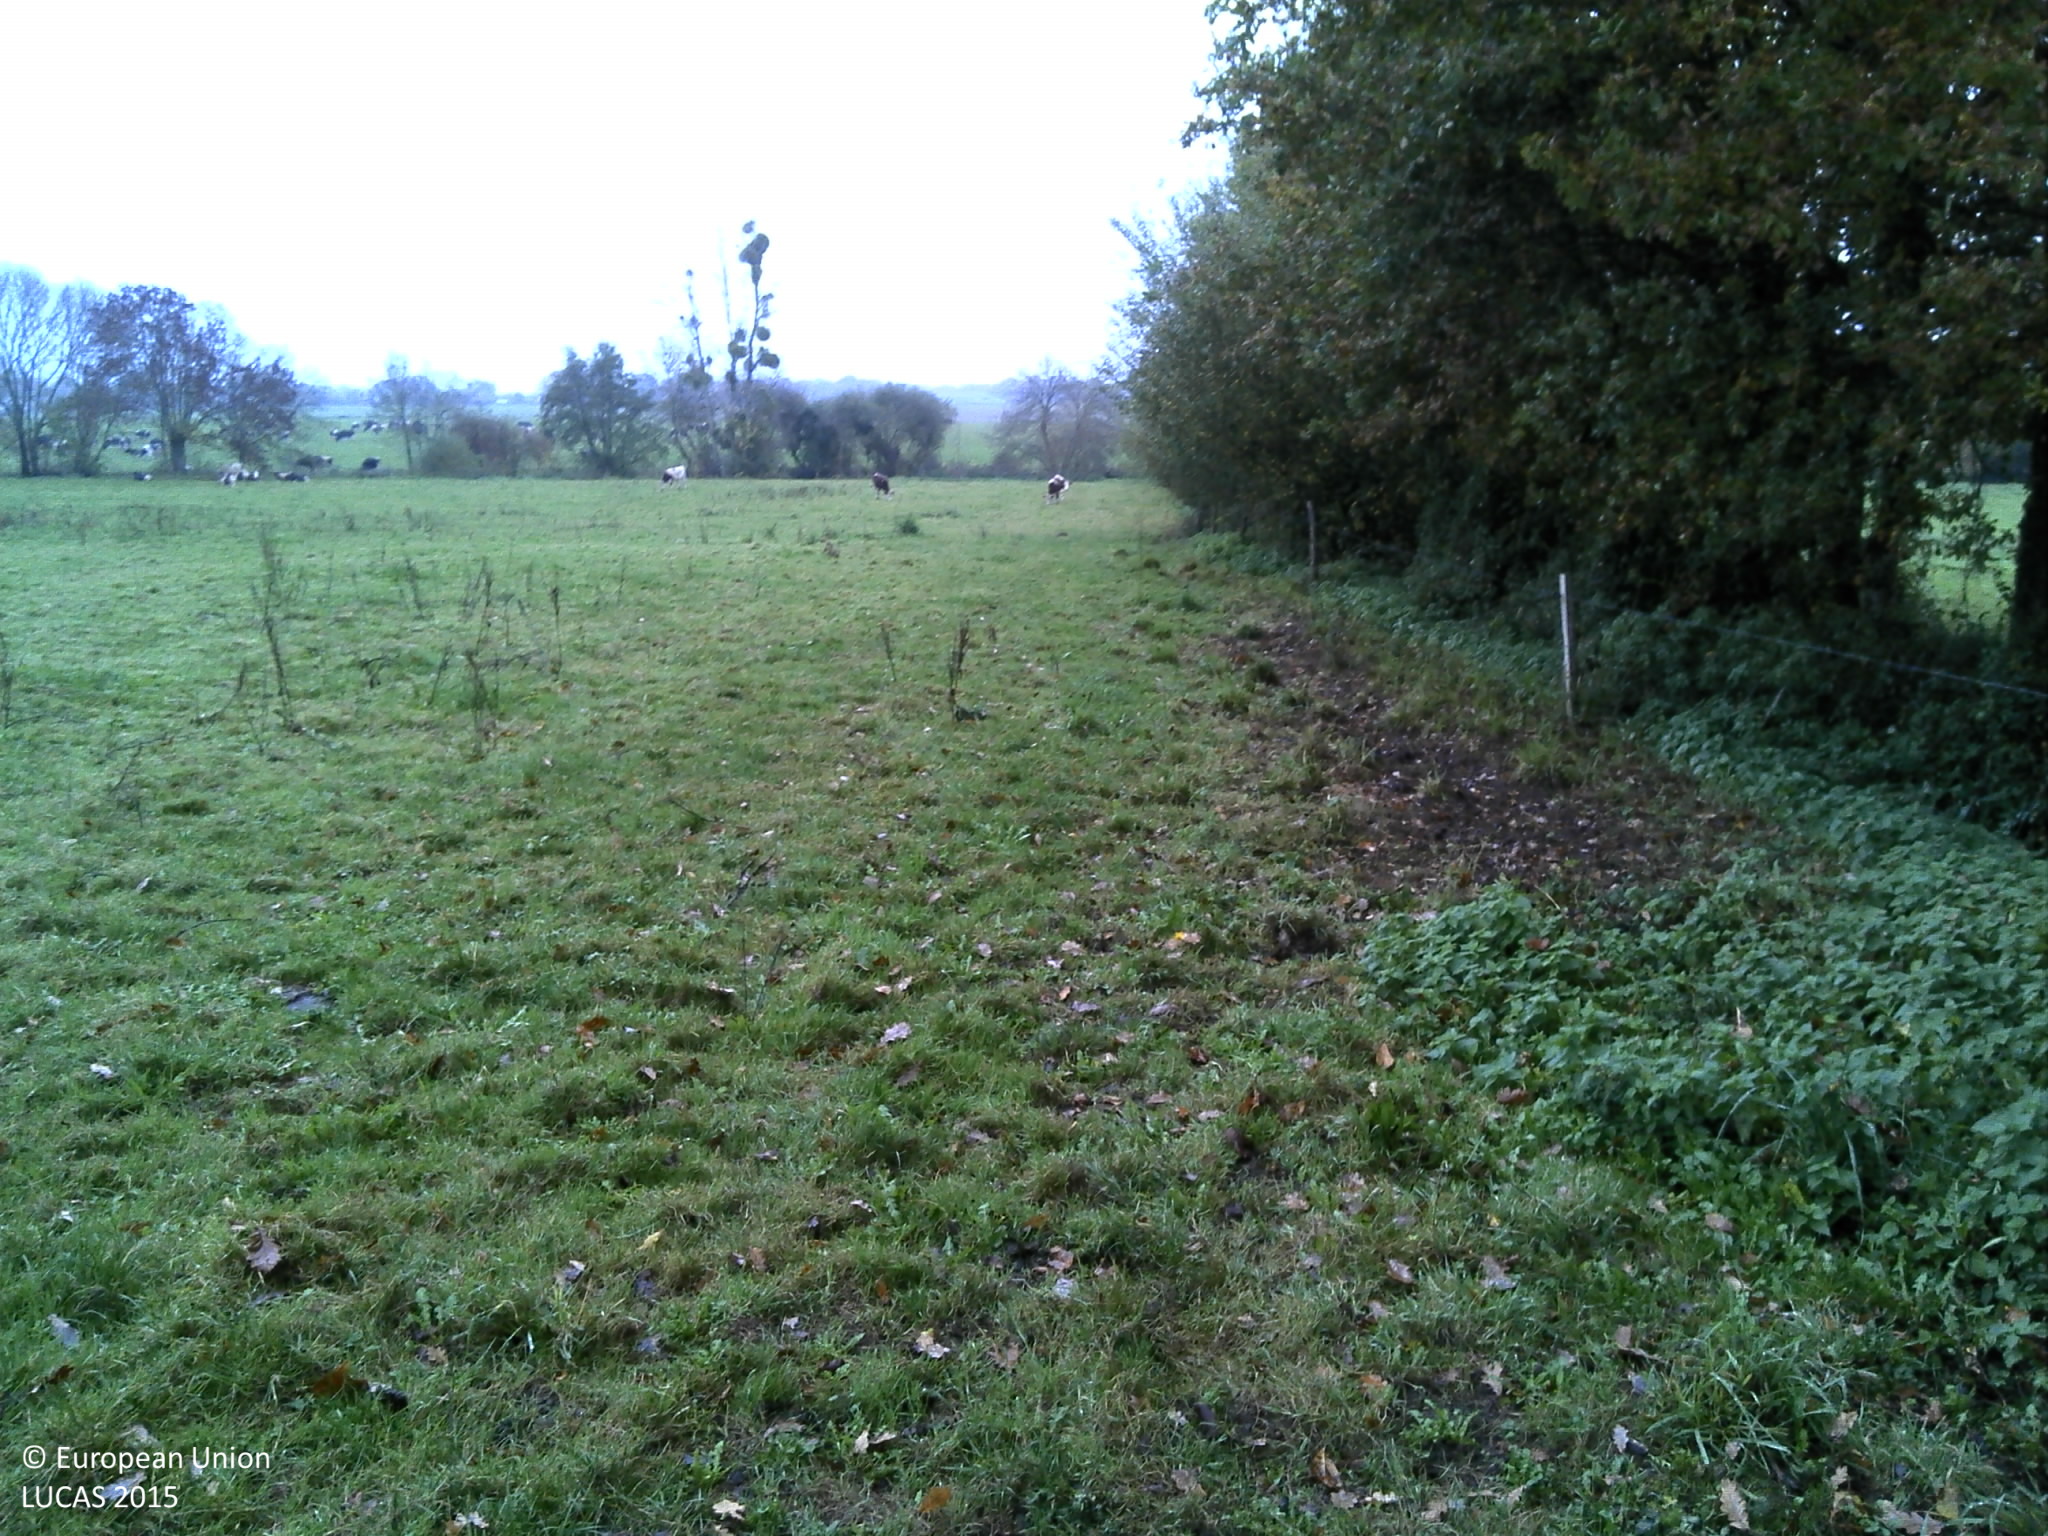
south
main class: Cropland
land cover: Temporary grasslands
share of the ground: > 75 %
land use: Agriculture (excluding fallow land and kitchen gardens)
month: November
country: FR
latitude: 47.6168
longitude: -1.5256
